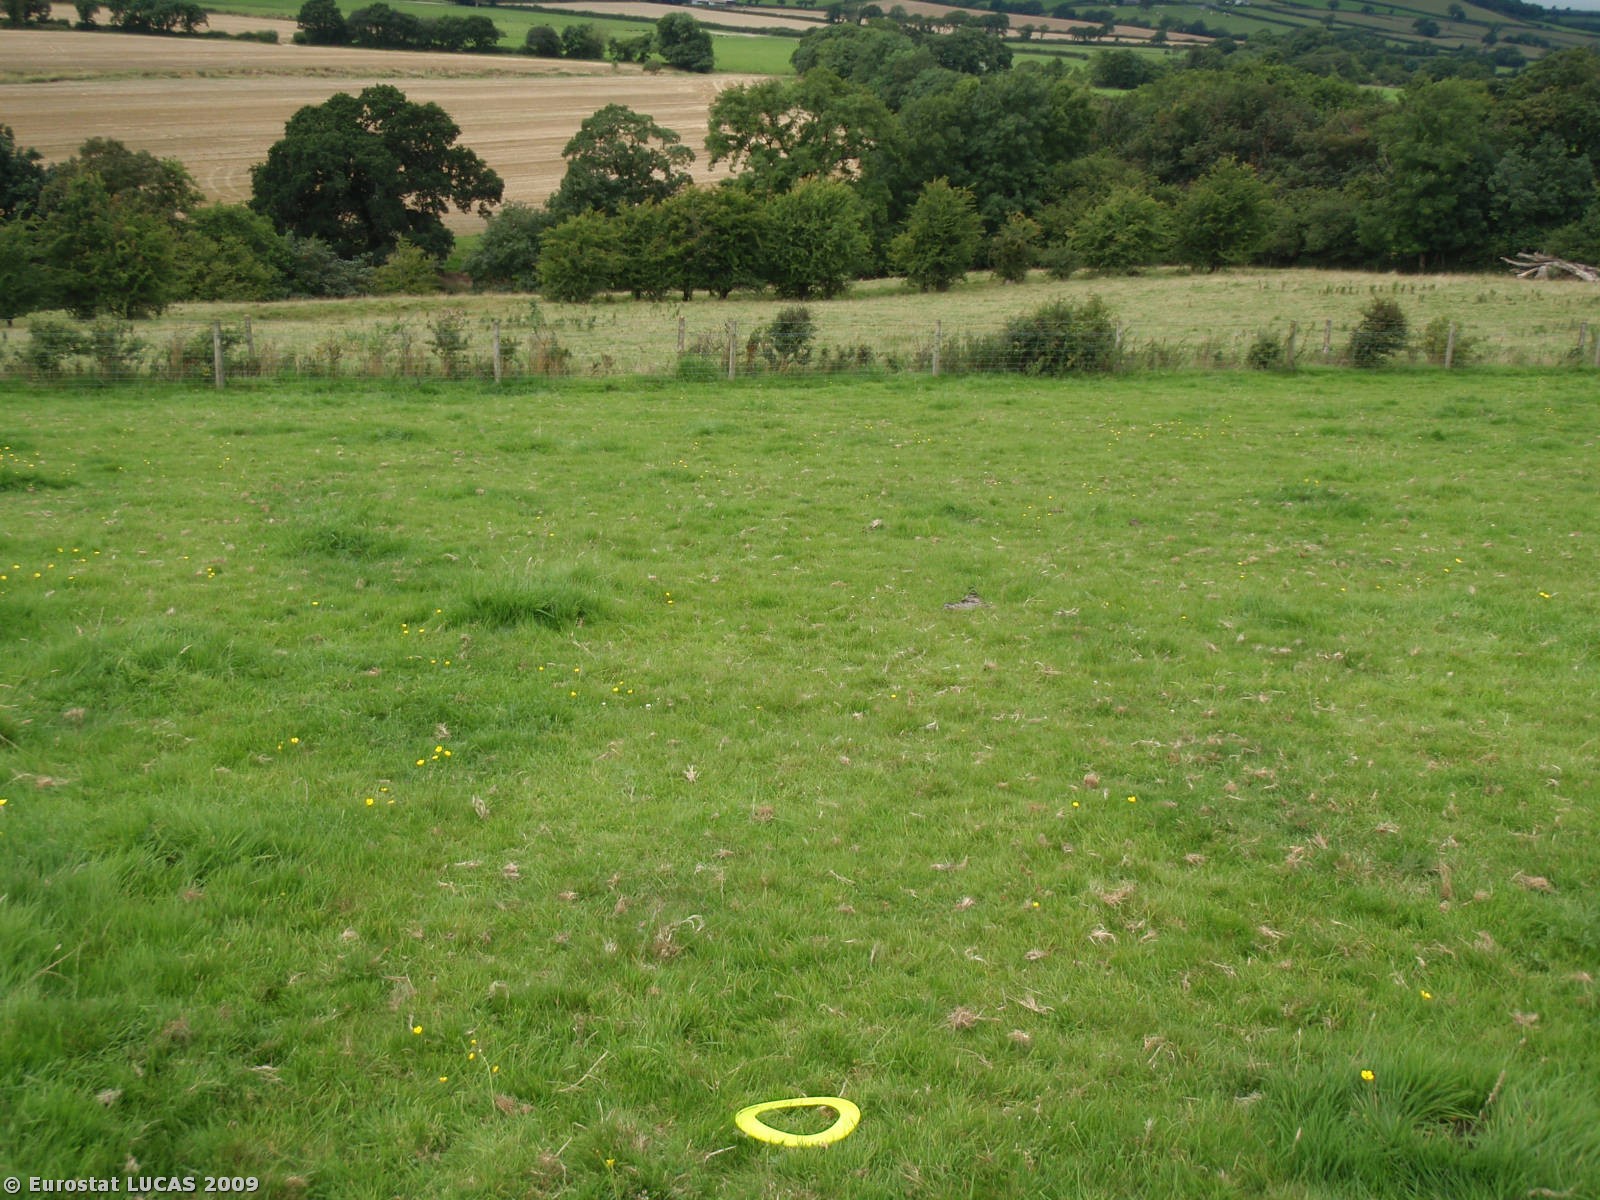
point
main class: Grassland
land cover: Grassland without tree/shrub cover
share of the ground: > 75 %
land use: Agriculture (excluding fallow land and kitchen gardens)
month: August
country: GB
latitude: 50.6101
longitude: -4.3022
